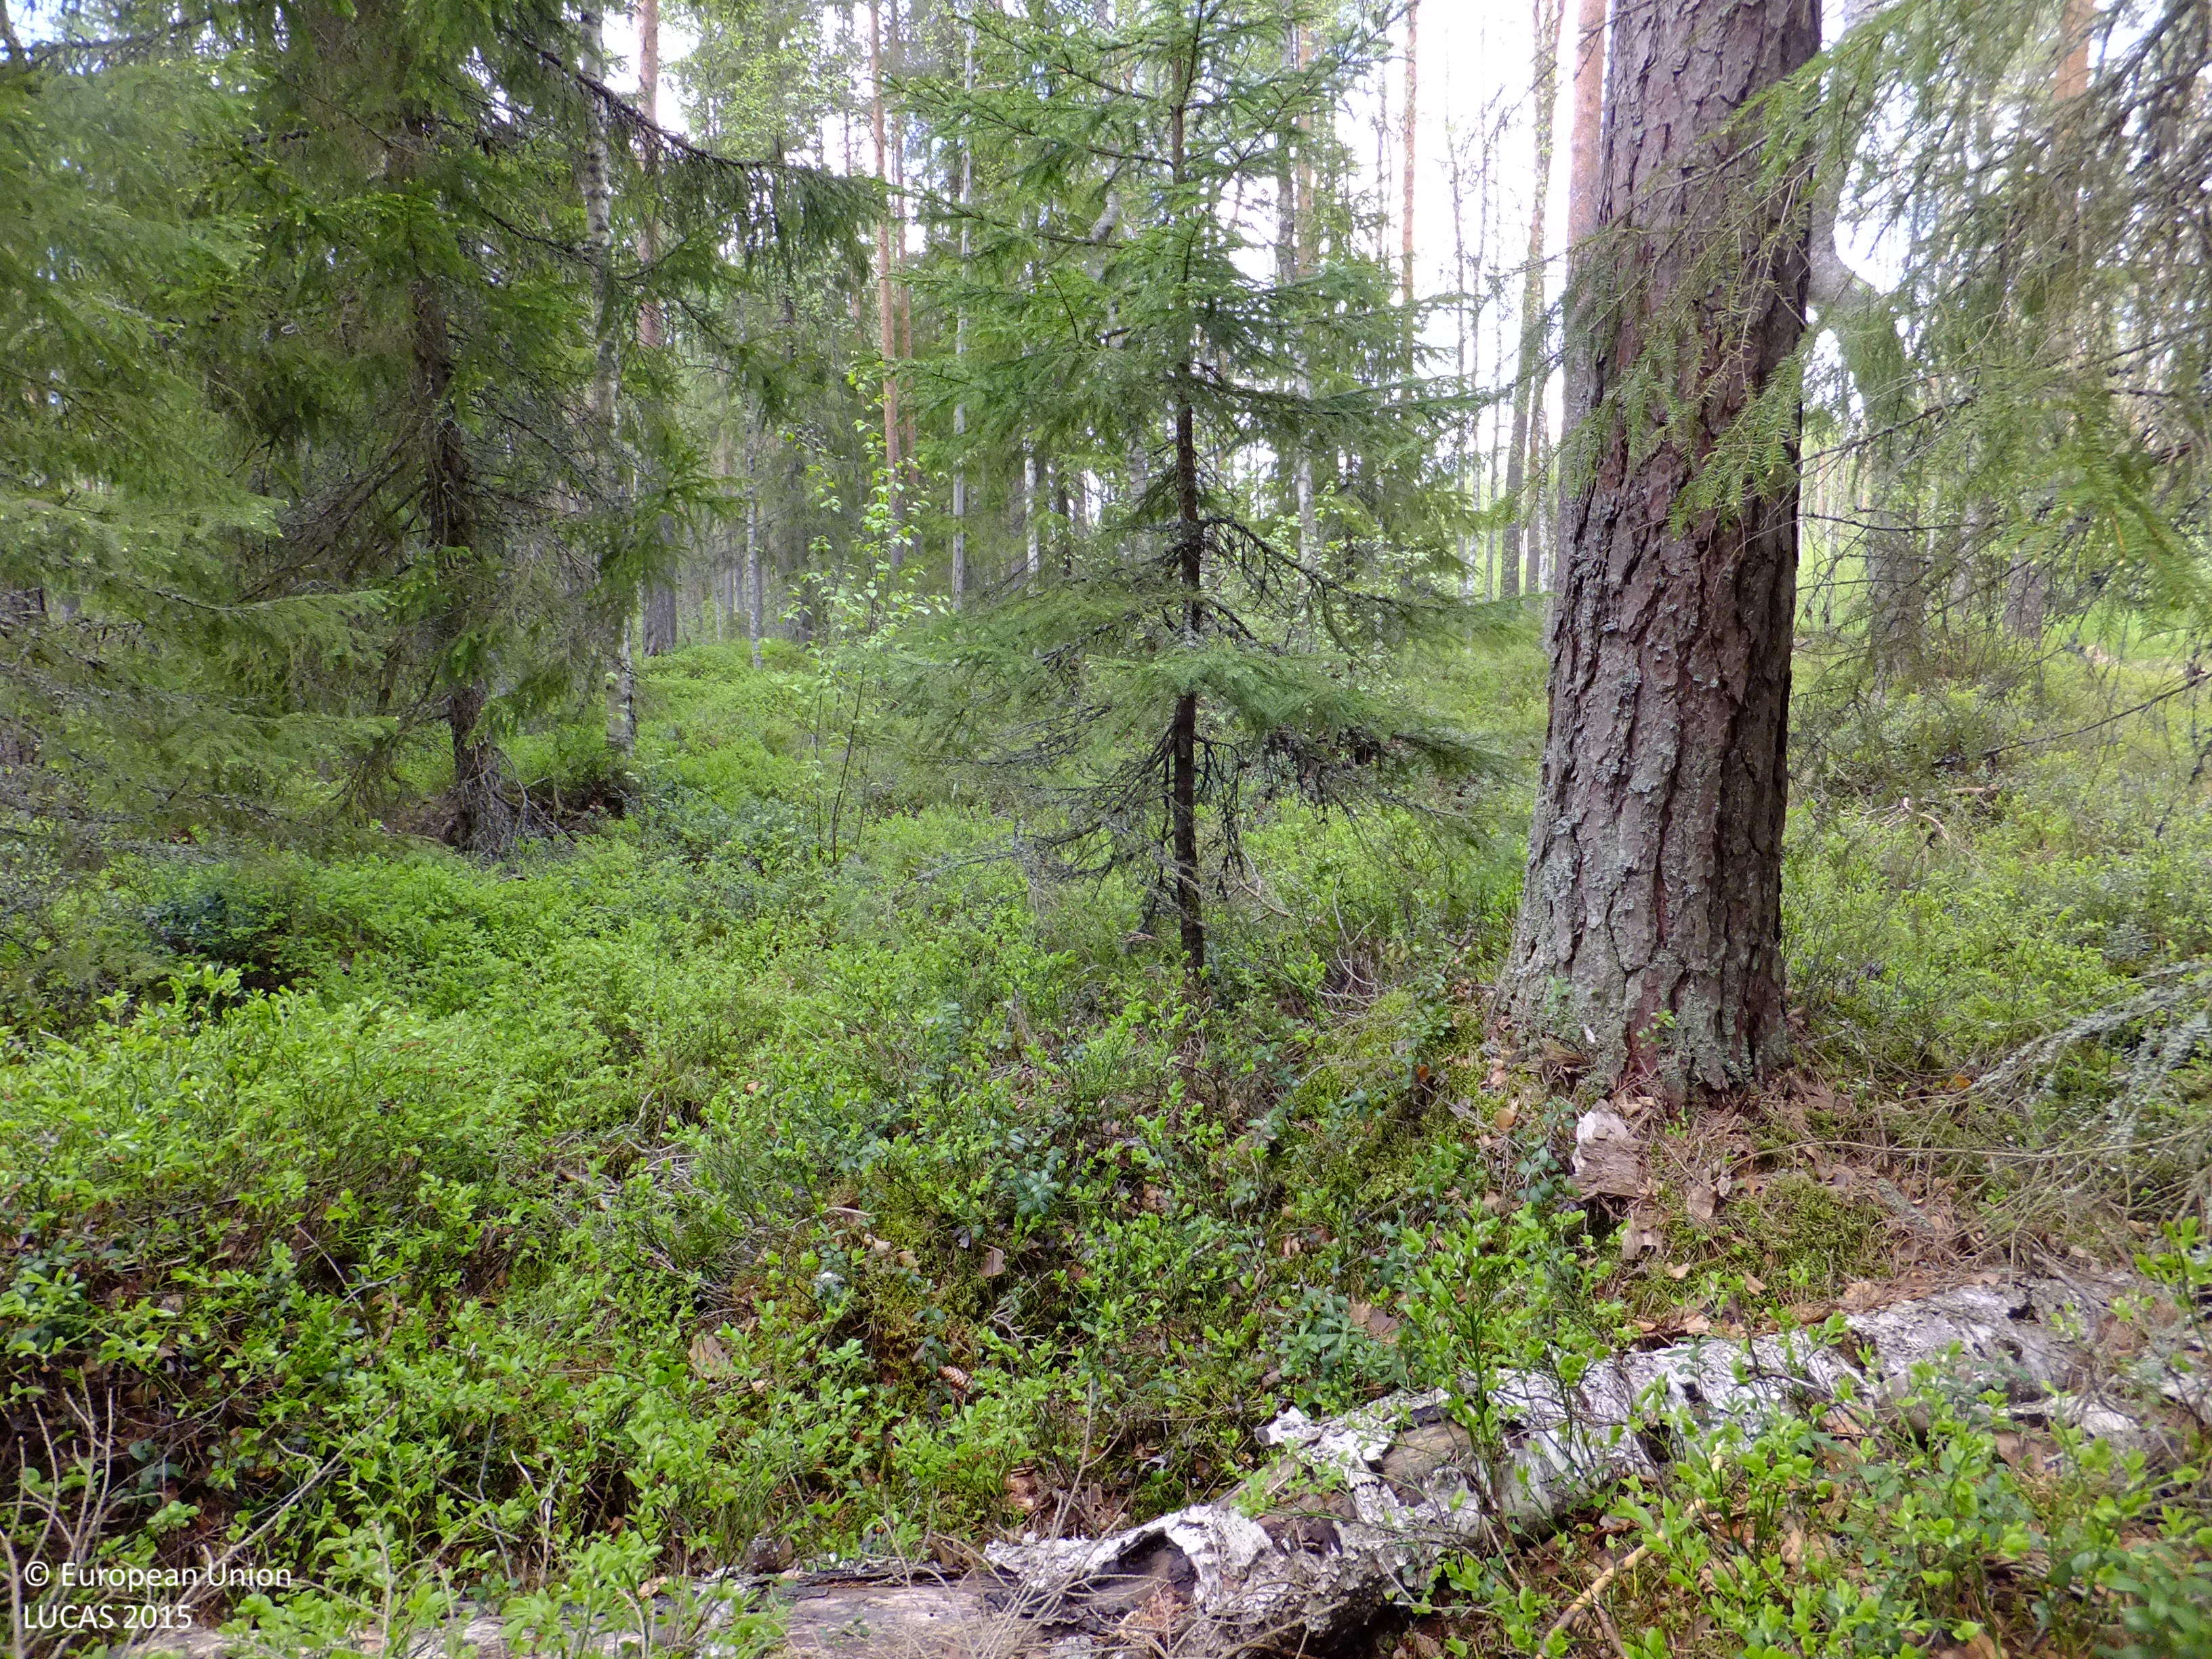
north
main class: Woodland
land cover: Spruce dominated mixed woodland
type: boreal forest
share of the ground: > 75 %
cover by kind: coniferous forest trees 50 %, broadleaved forest trees 30 %, shrubs 20 %
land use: Forestry
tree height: > 5 m
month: May
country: FI
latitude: 63.6112
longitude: 22.6930
